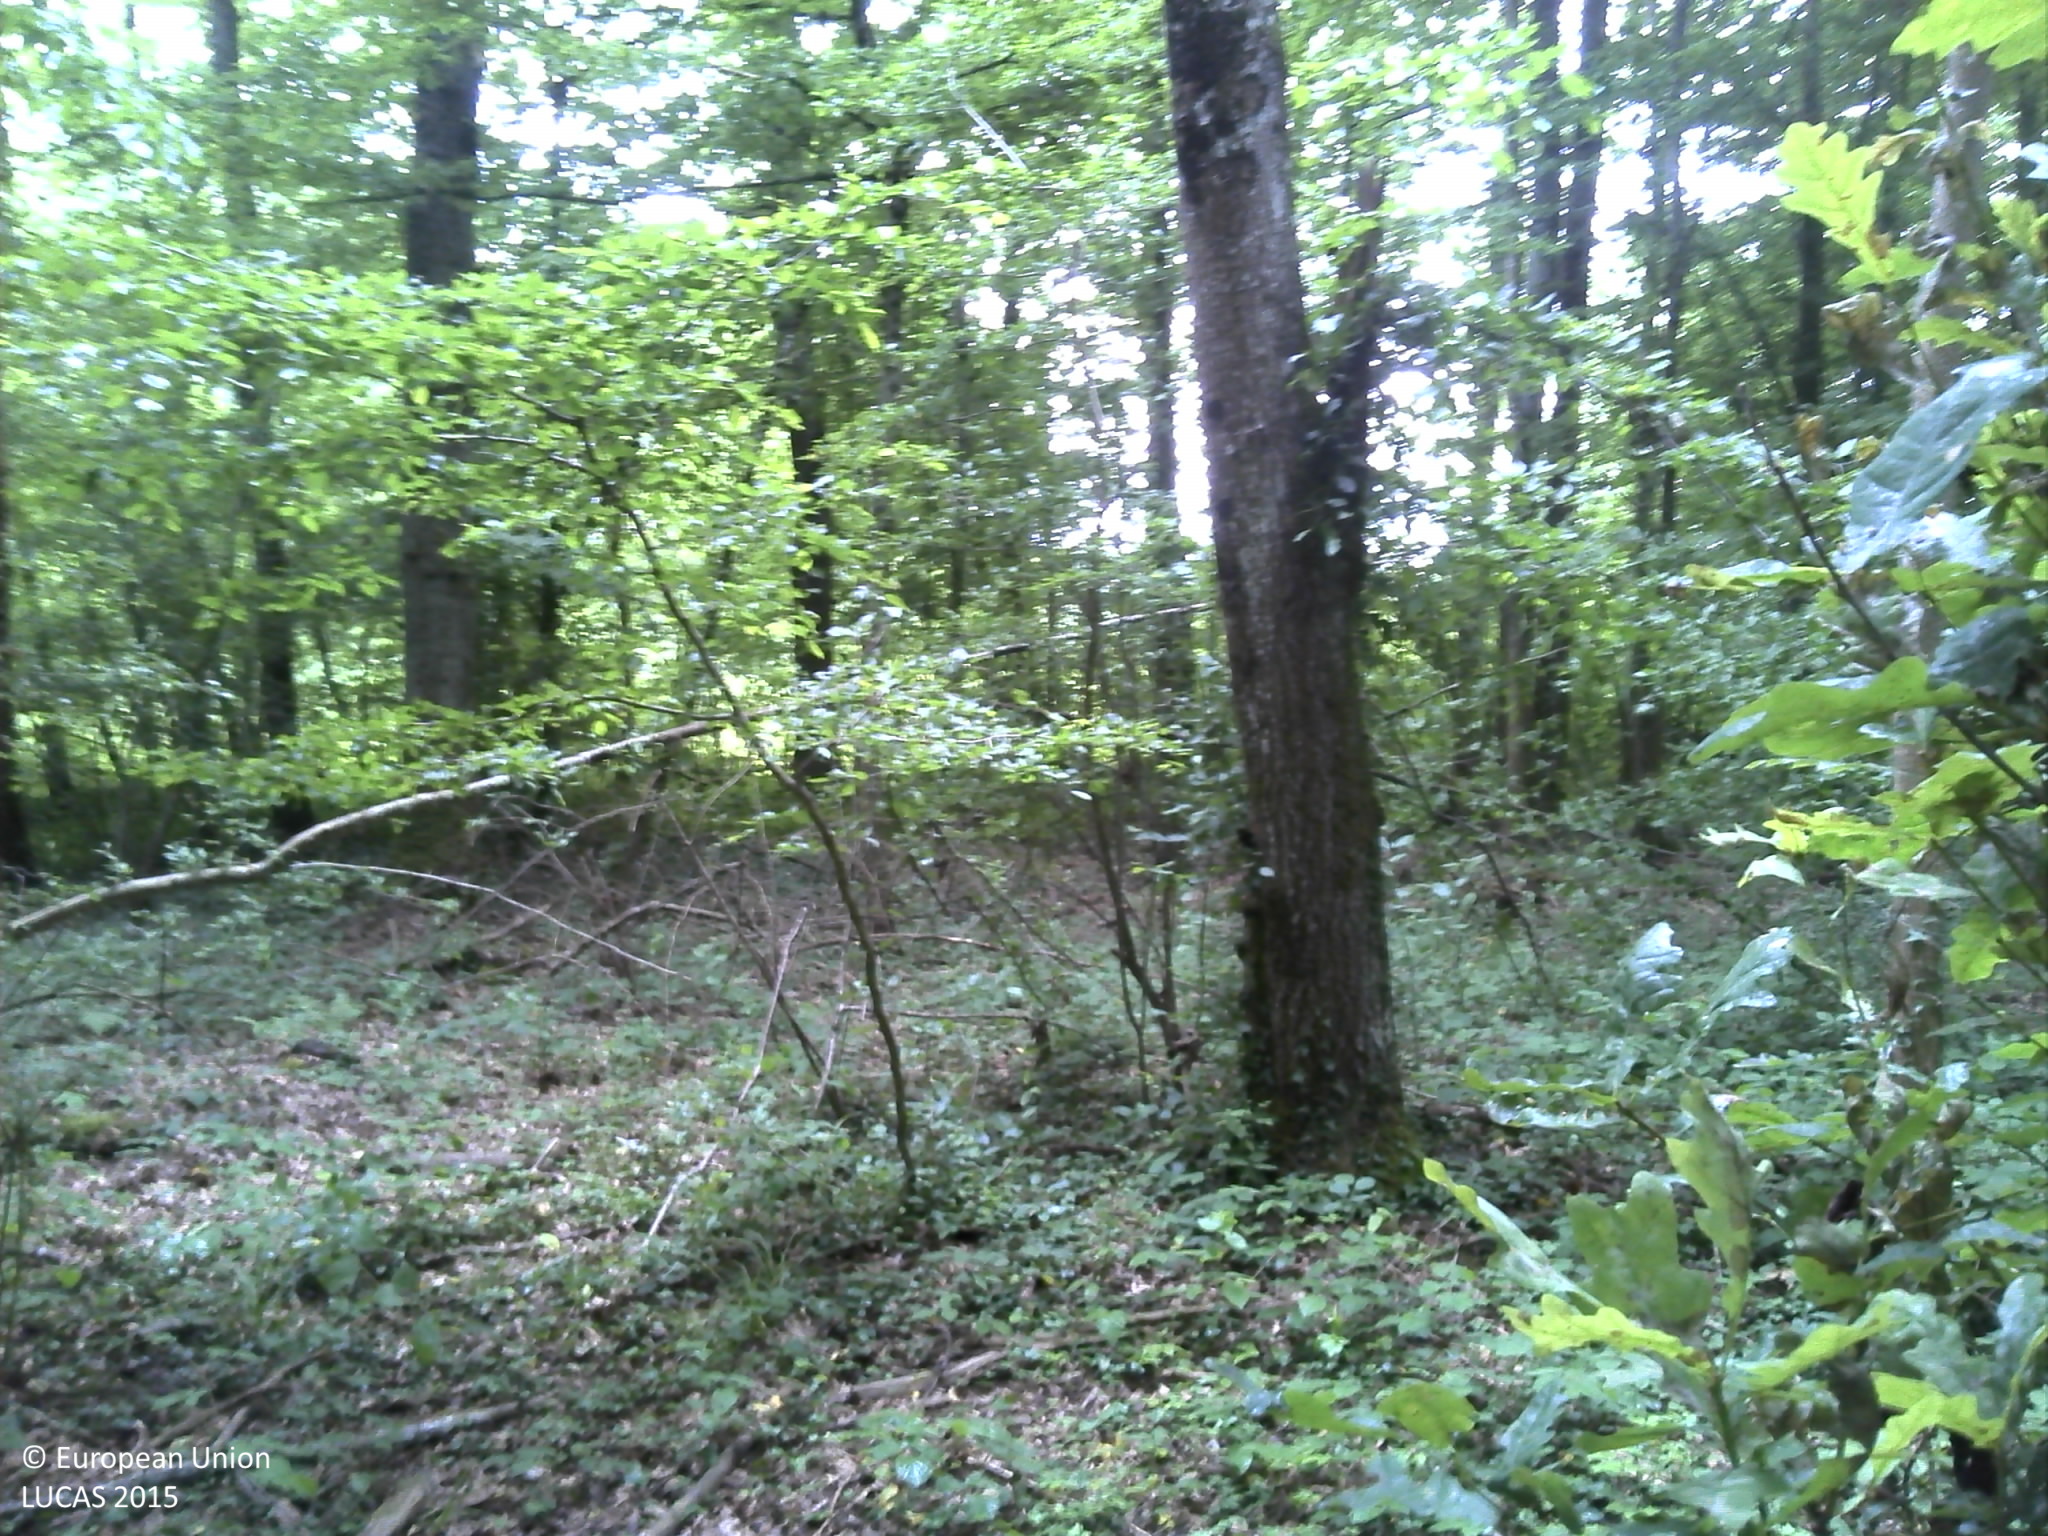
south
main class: Woodland
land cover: Broadleaved woodland
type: acidophilous oak and oak-birch forest
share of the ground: > 75 %
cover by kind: broadleaved forest trees 65 %, herbaceous plants 15 %, consolidated bare surface 15 %, lichens and mosses 5 %
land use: Forestry
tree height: > 5 m
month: July
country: FR
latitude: 49.7843
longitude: 4.5657
